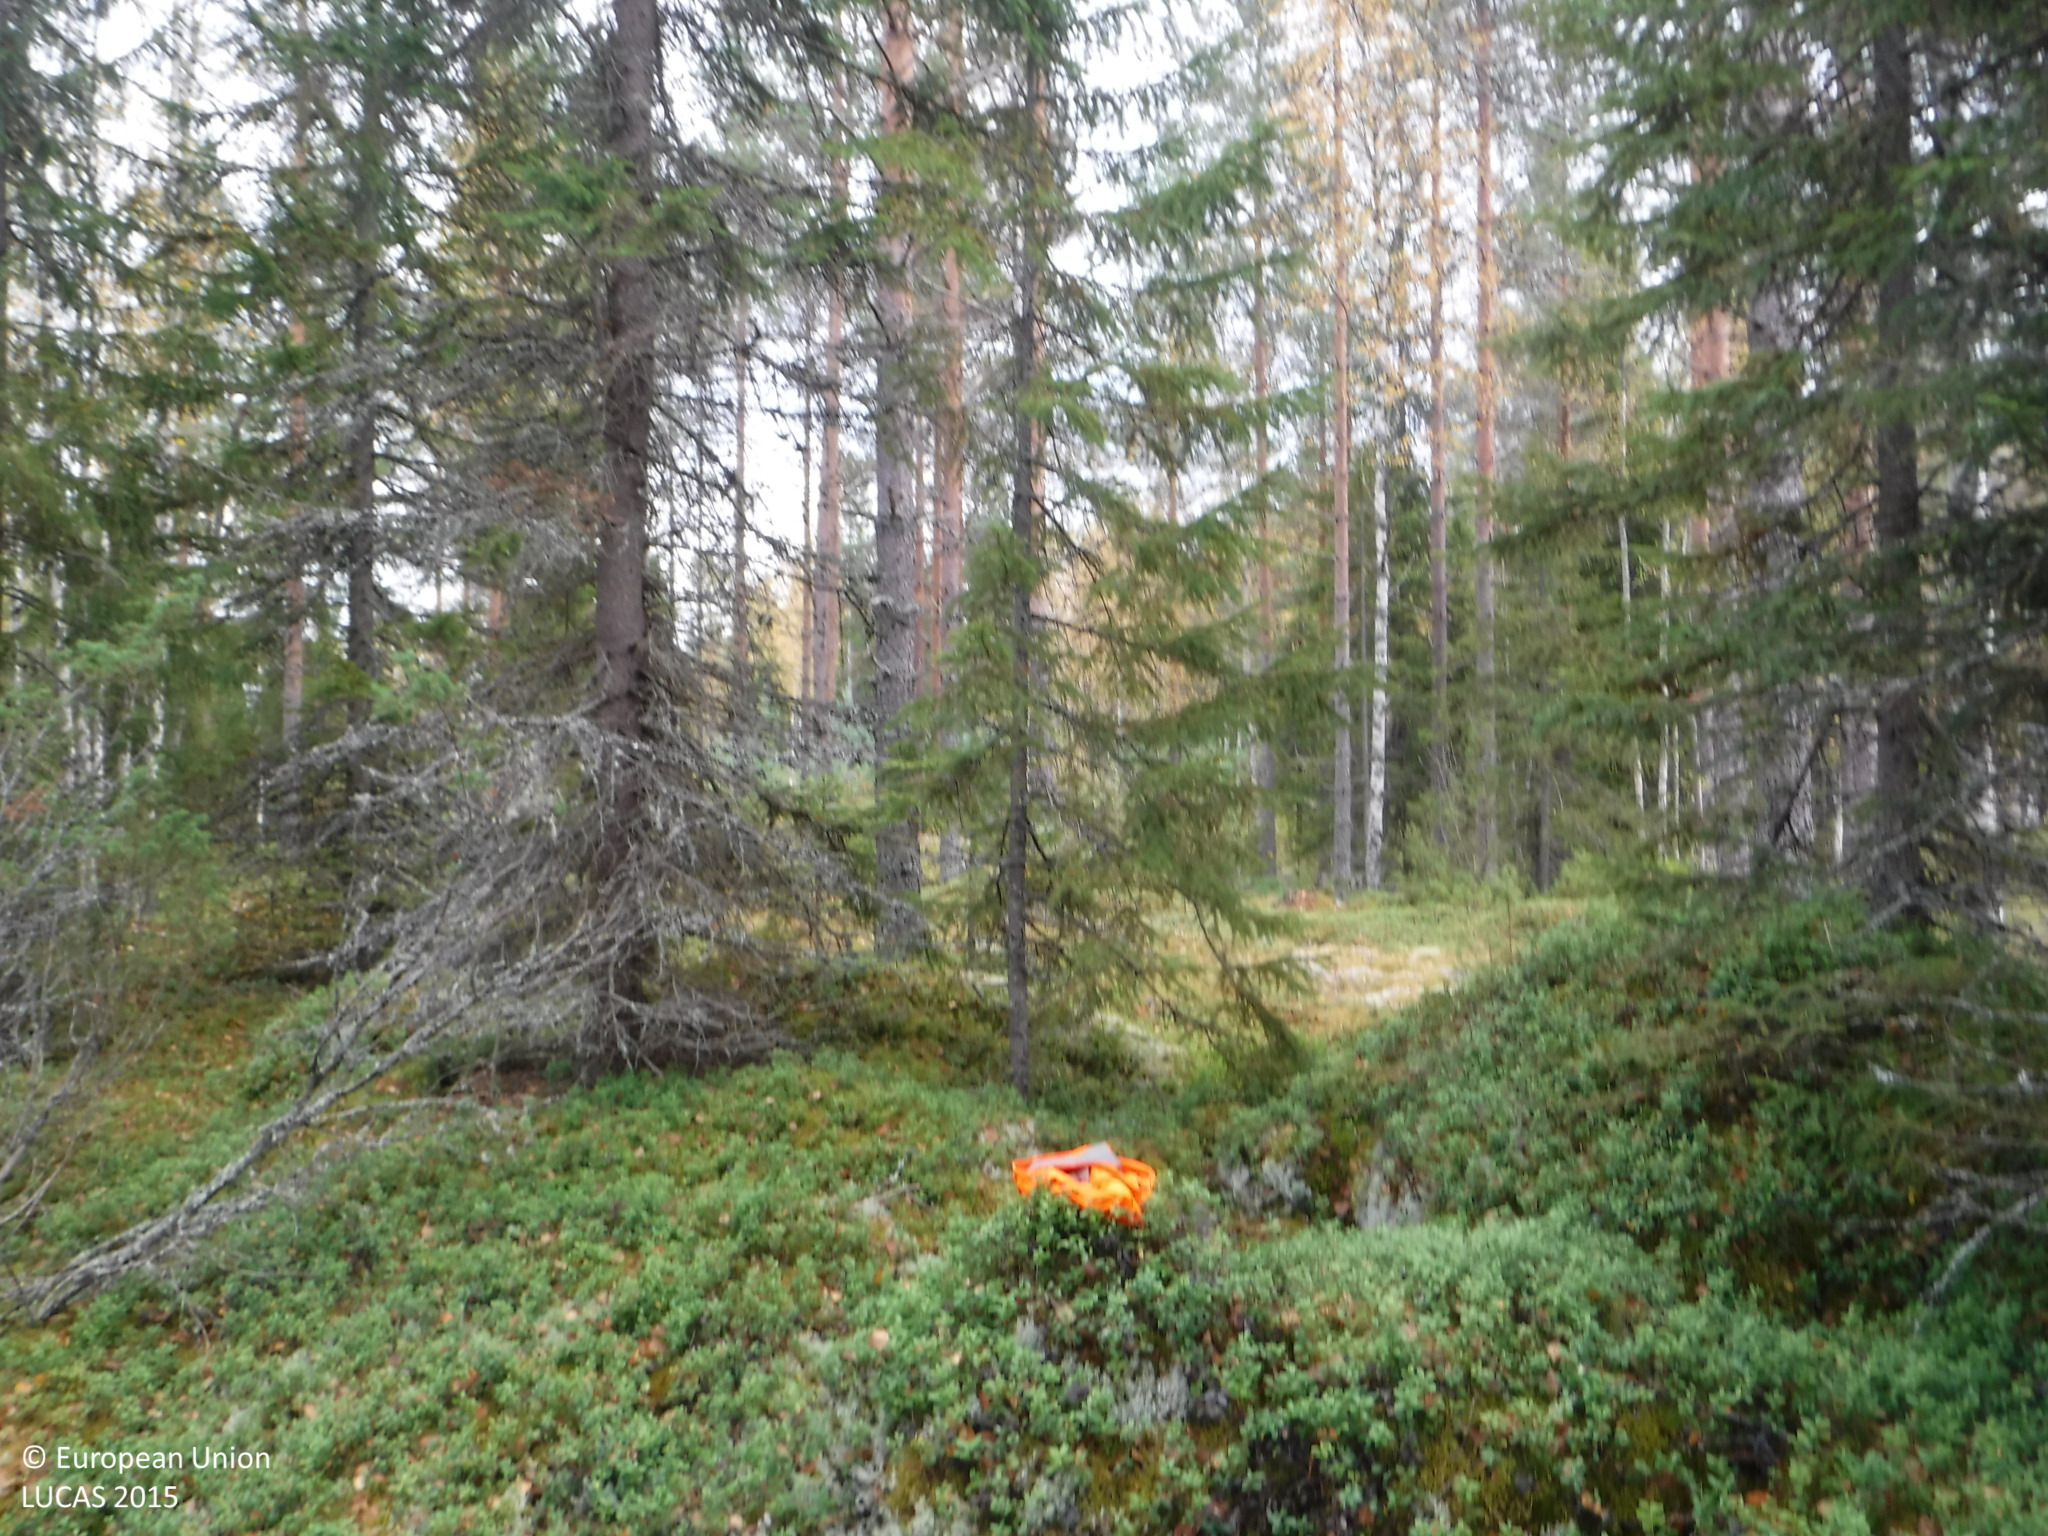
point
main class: Woodland
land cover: Other mixed woodland
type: boreal forest
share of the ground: 50 - 75 %
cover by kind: coniferous forest trees 25 %, broadleaved forest trees 25 %, shrubs 25 %, lichens and mosses 25 %
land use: Forestry
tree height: > 5 m
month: September
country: FI
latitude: 62.0356
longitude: 23.3194
